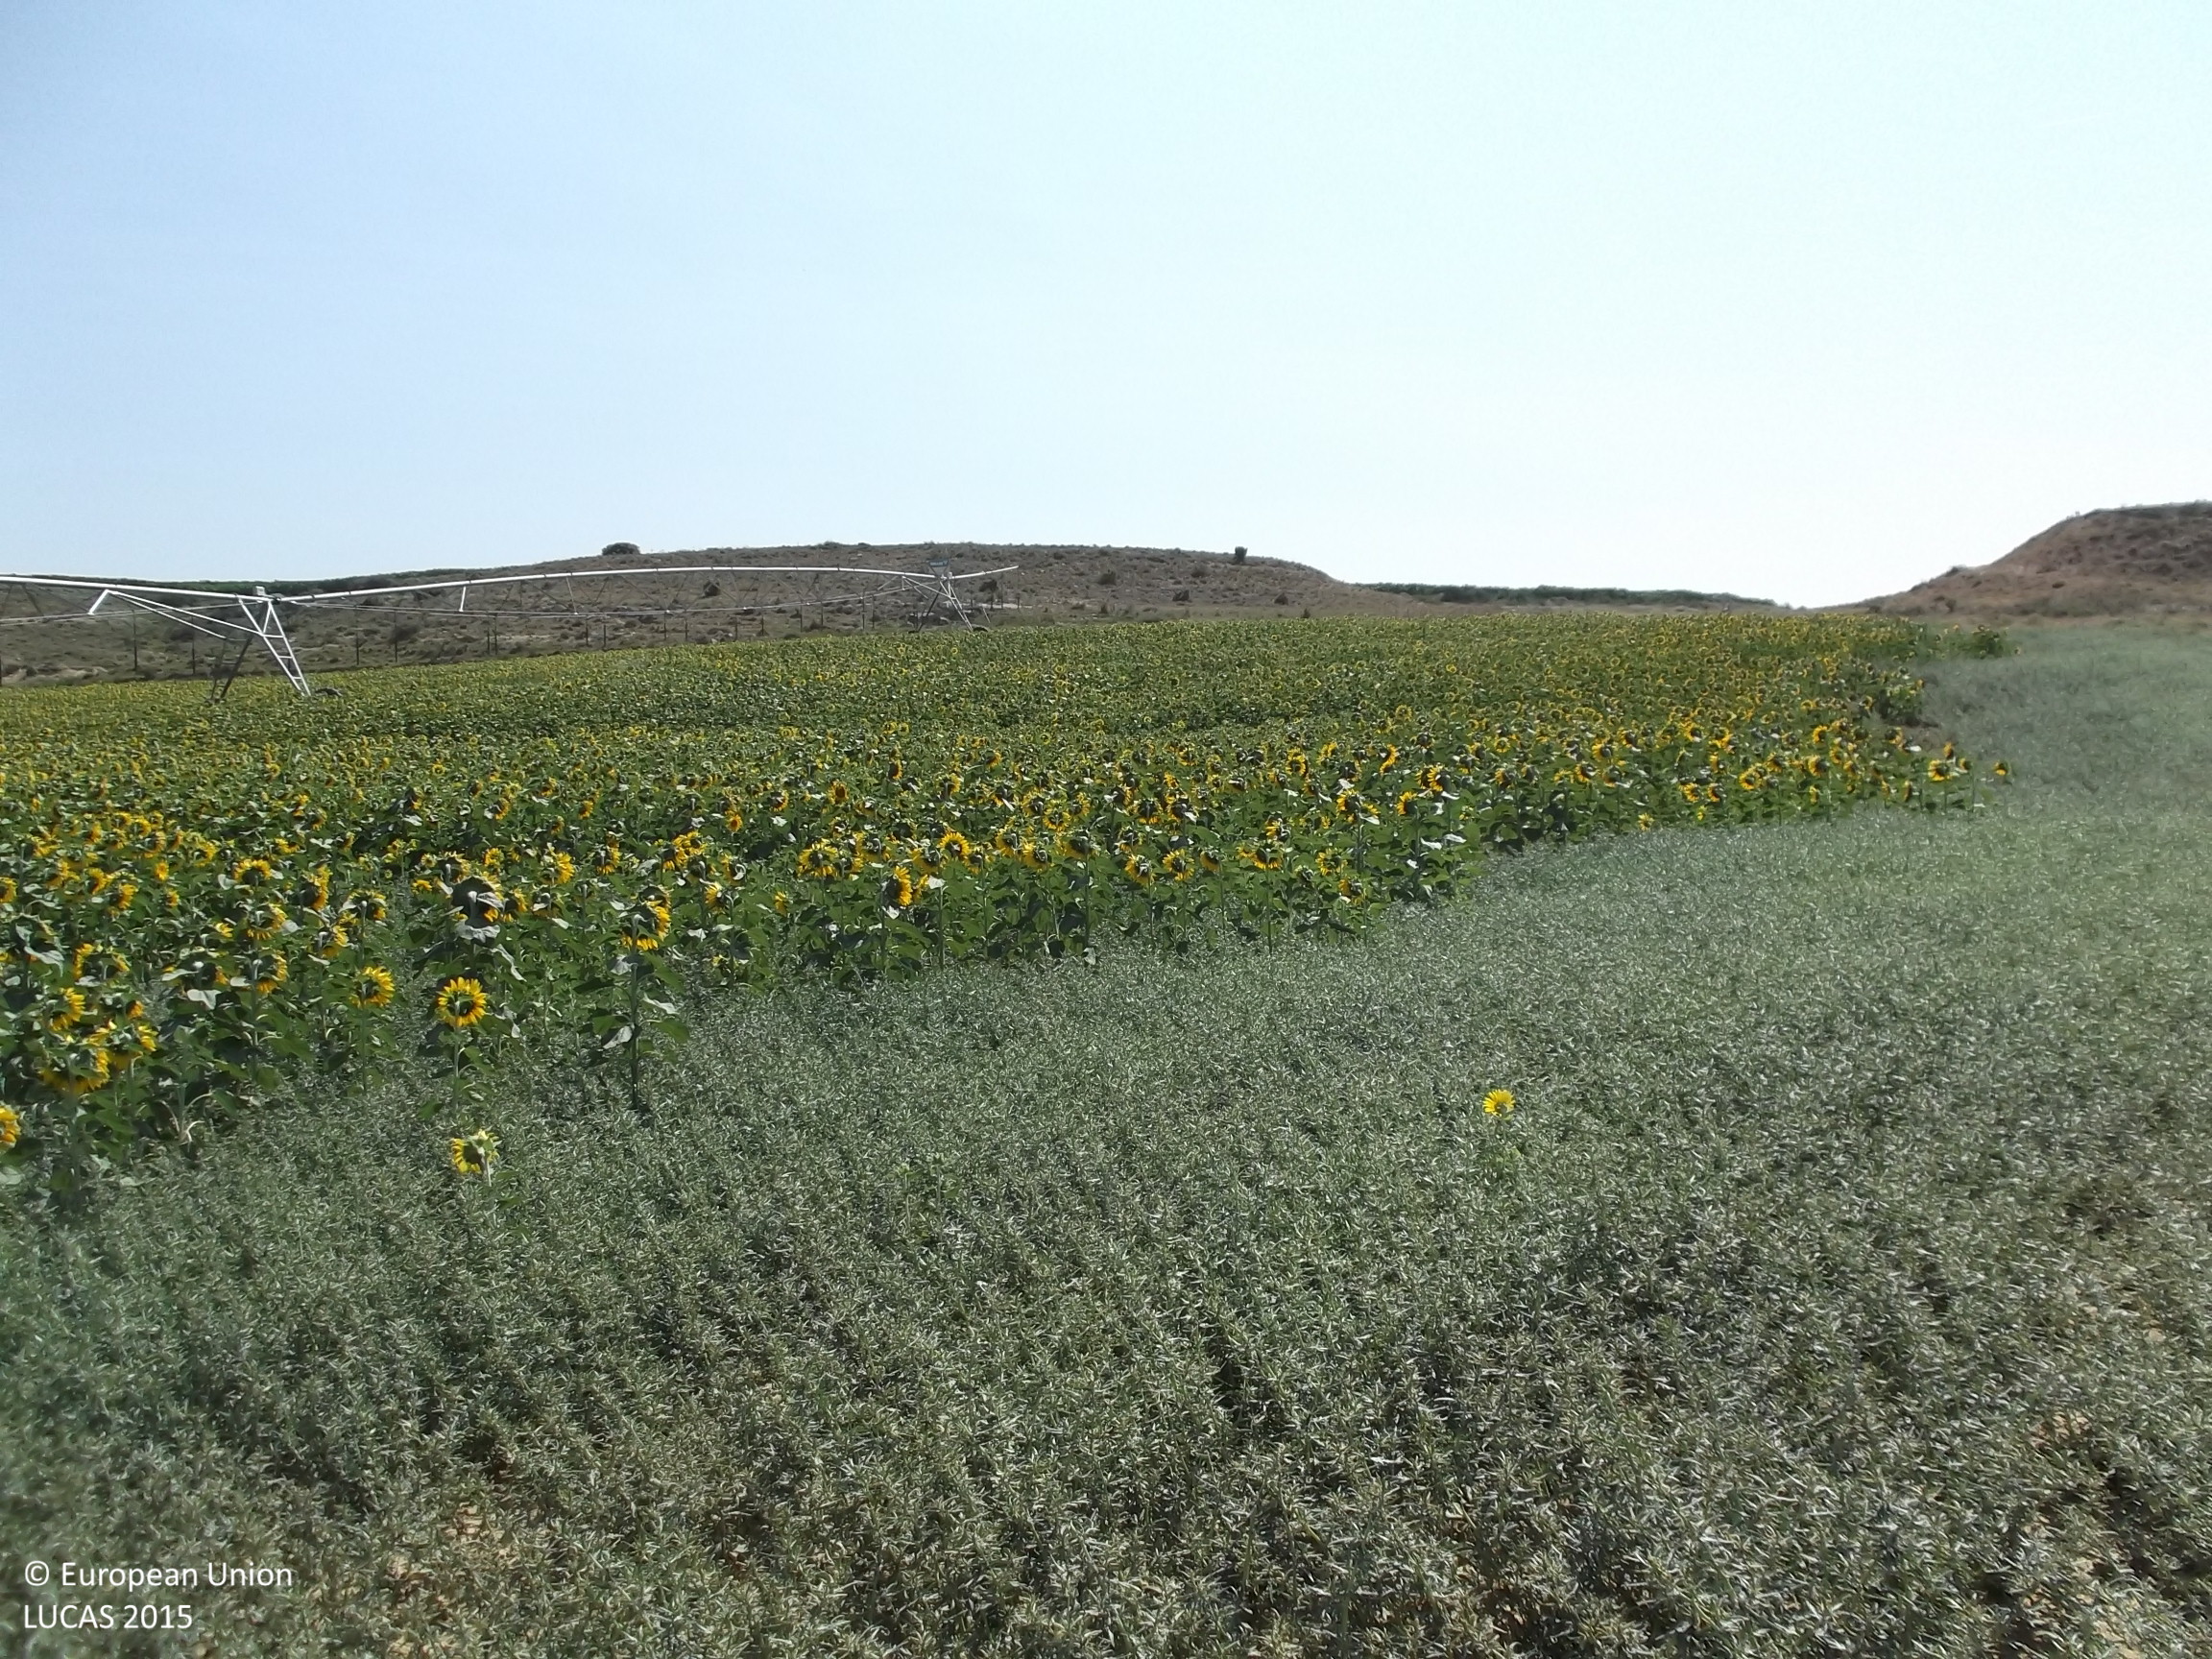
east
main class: Cropland
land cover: Sunflower
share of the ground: > 75 %
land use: Agriculture (excluding fallow land and kitchen gardens)
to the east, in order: Grass margins; Sunflower; Shrubland without tree cover; Maize
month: July
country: ES
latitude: 42.4768
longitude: -1.6037
